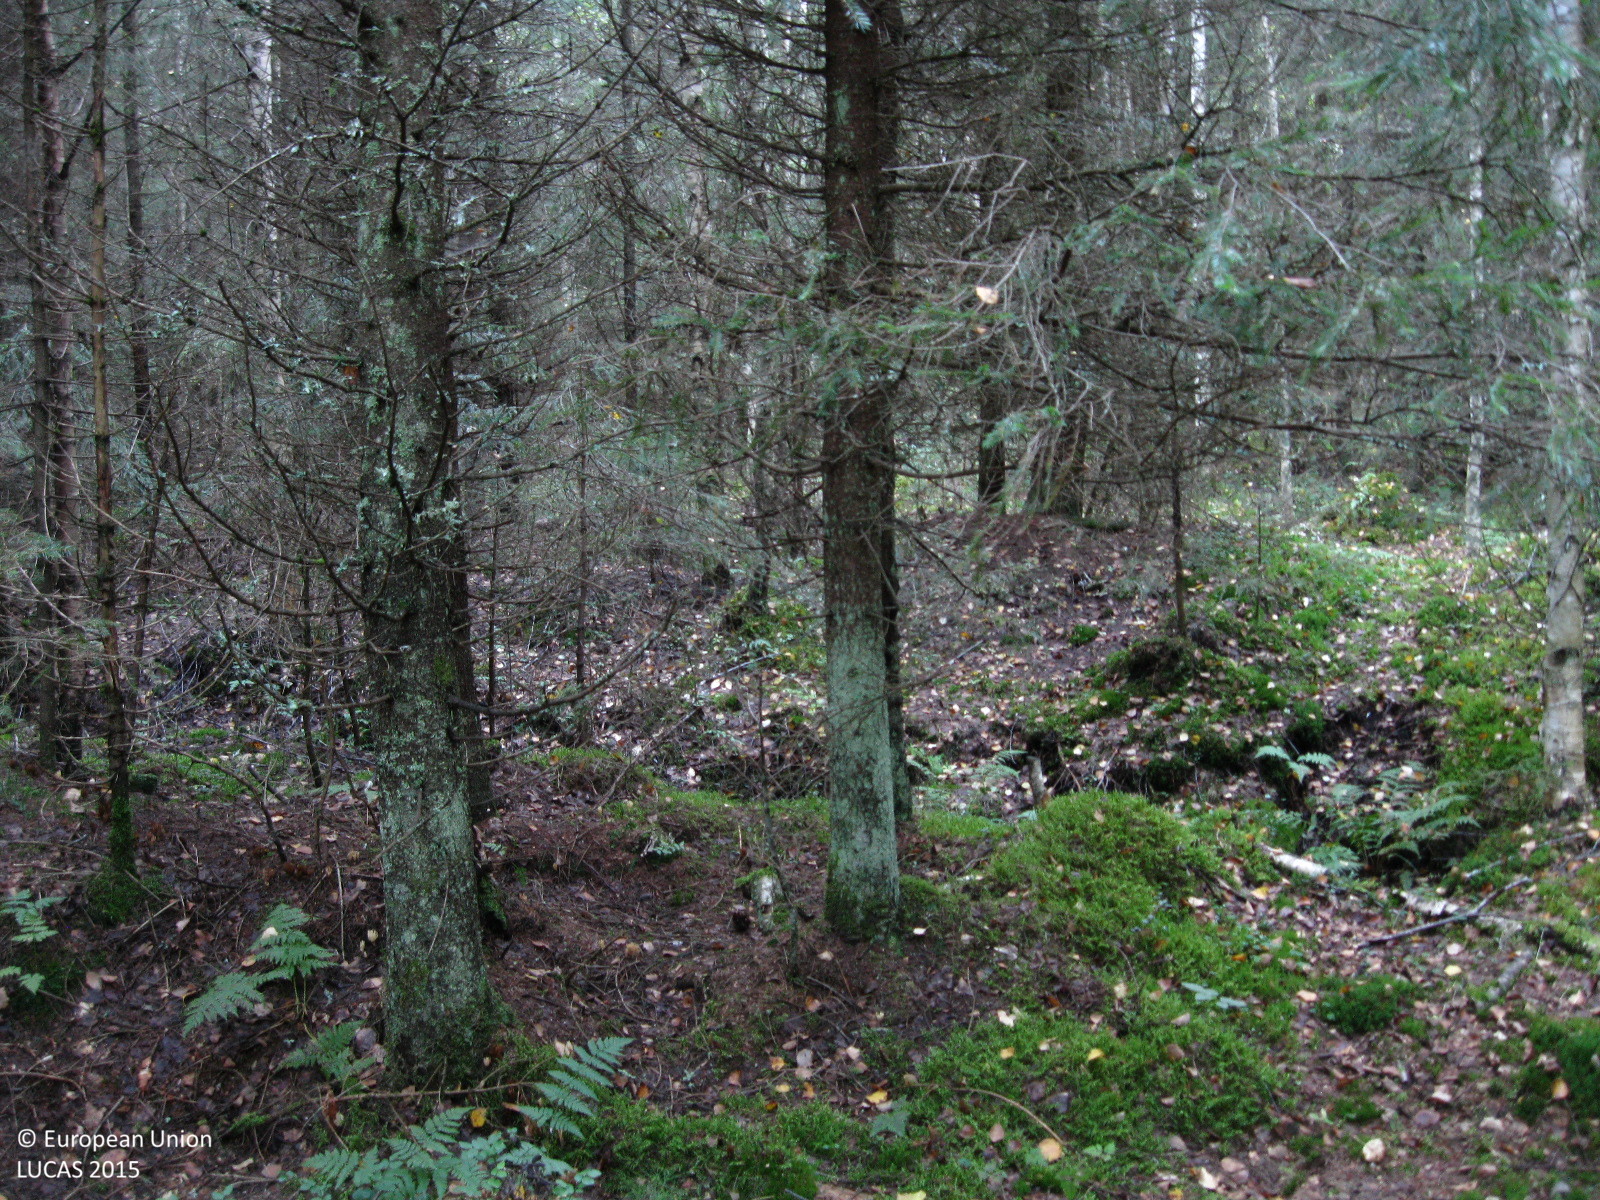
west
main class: Woodland
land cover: Spruce dominated mixed woodland
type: boreal forest
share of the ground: > 75 %
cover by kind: coniferous forest trees 45 %, broadleaved forest trees 40 %, lichens and mosses 15 %
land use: Forestry
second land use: Amenities, museums, leisure
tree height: > 5 m
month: September
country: FI
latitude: 60.6331
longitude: 24.7161
